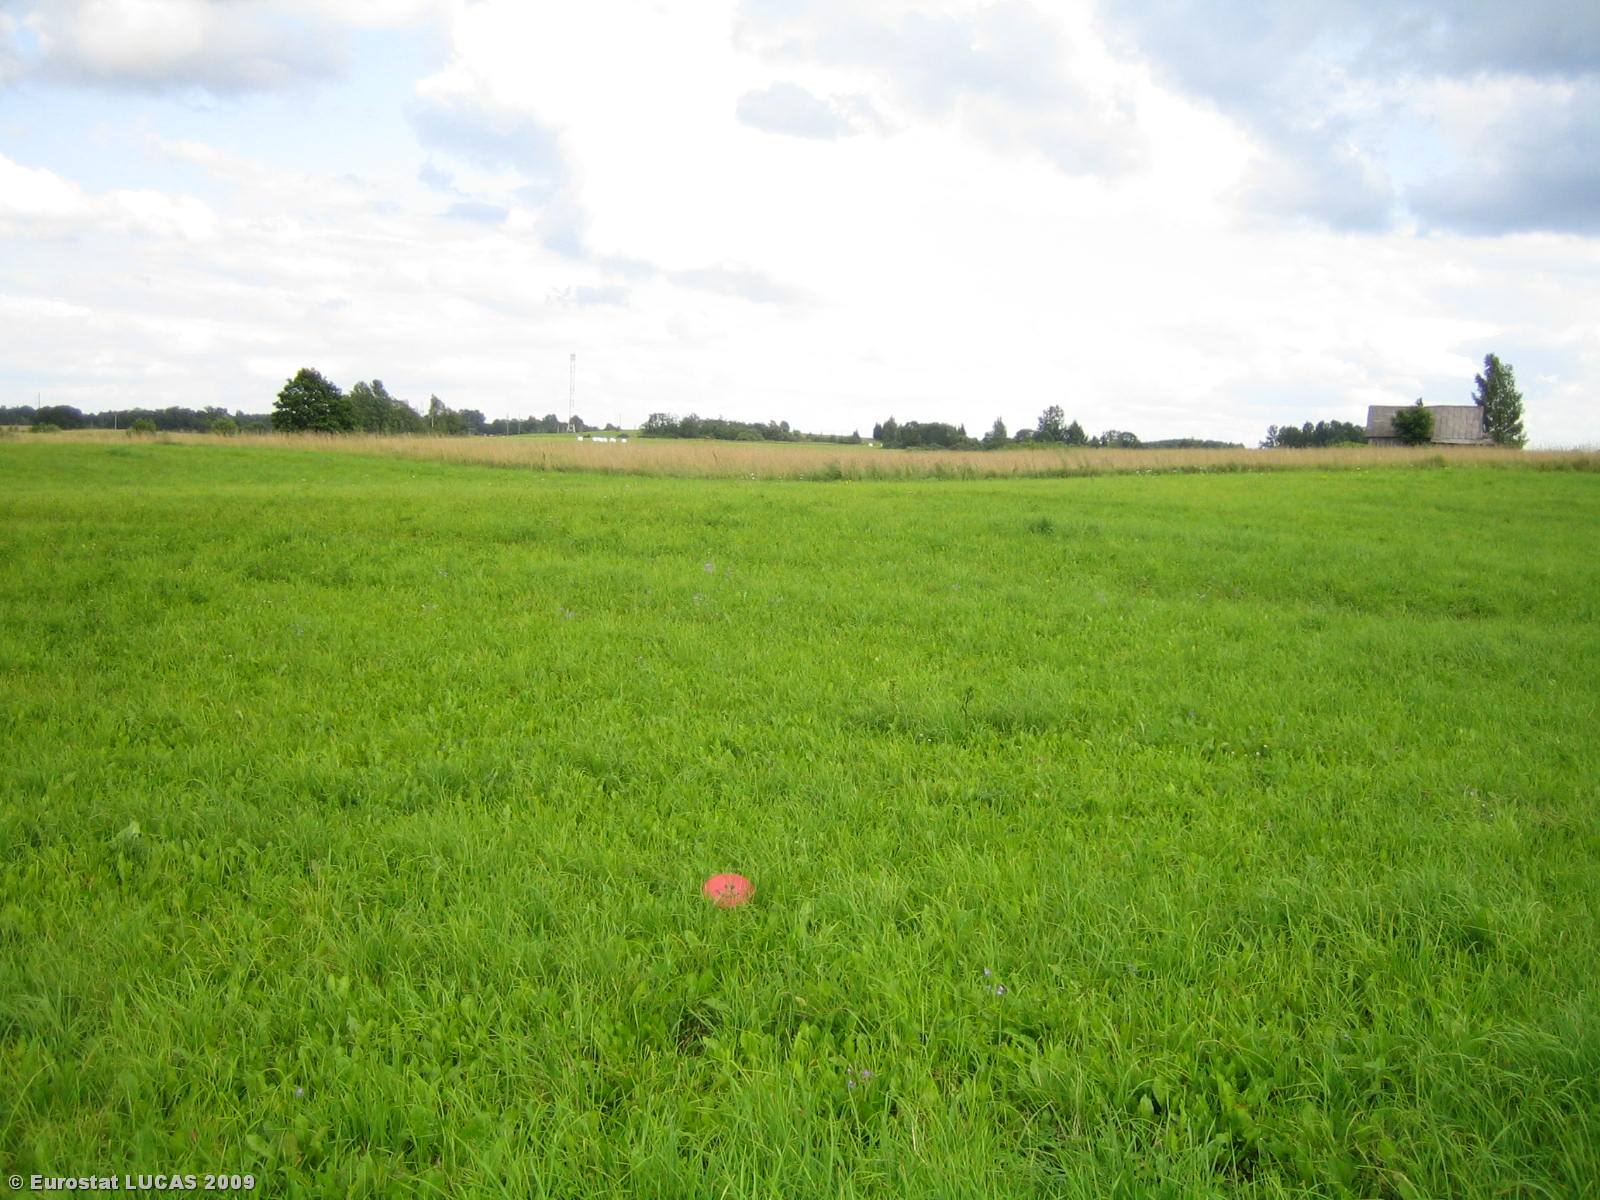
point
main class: Grassland
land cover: Grassland without tree/shrub cover
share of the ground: > 75 %
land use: Agriculture (excluding fallow land and kitchen gardens)
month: July
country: LT
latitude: 55.4562
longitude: 25.8034
